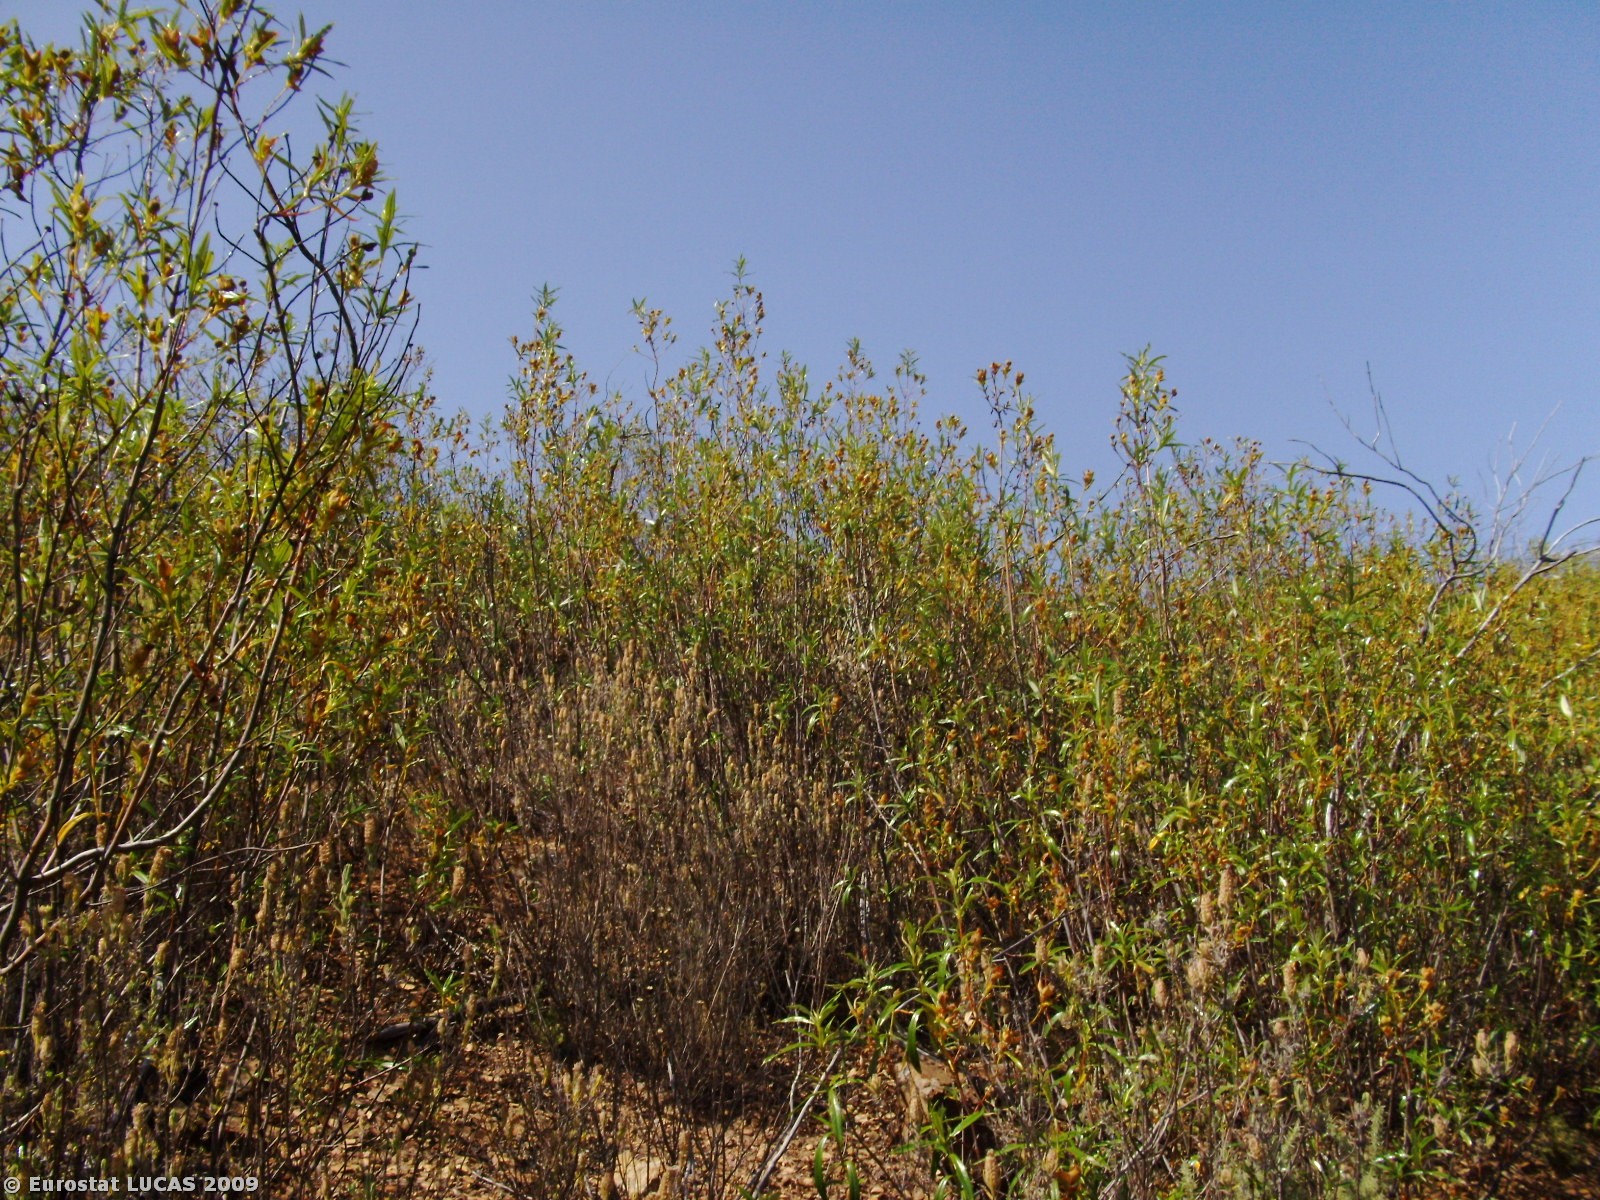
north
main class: Shrubland
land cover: Shrubland without tree cover
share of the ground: > 75 %
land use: Unused
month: June
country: PT
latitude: 37.2005
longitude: -8.4687
